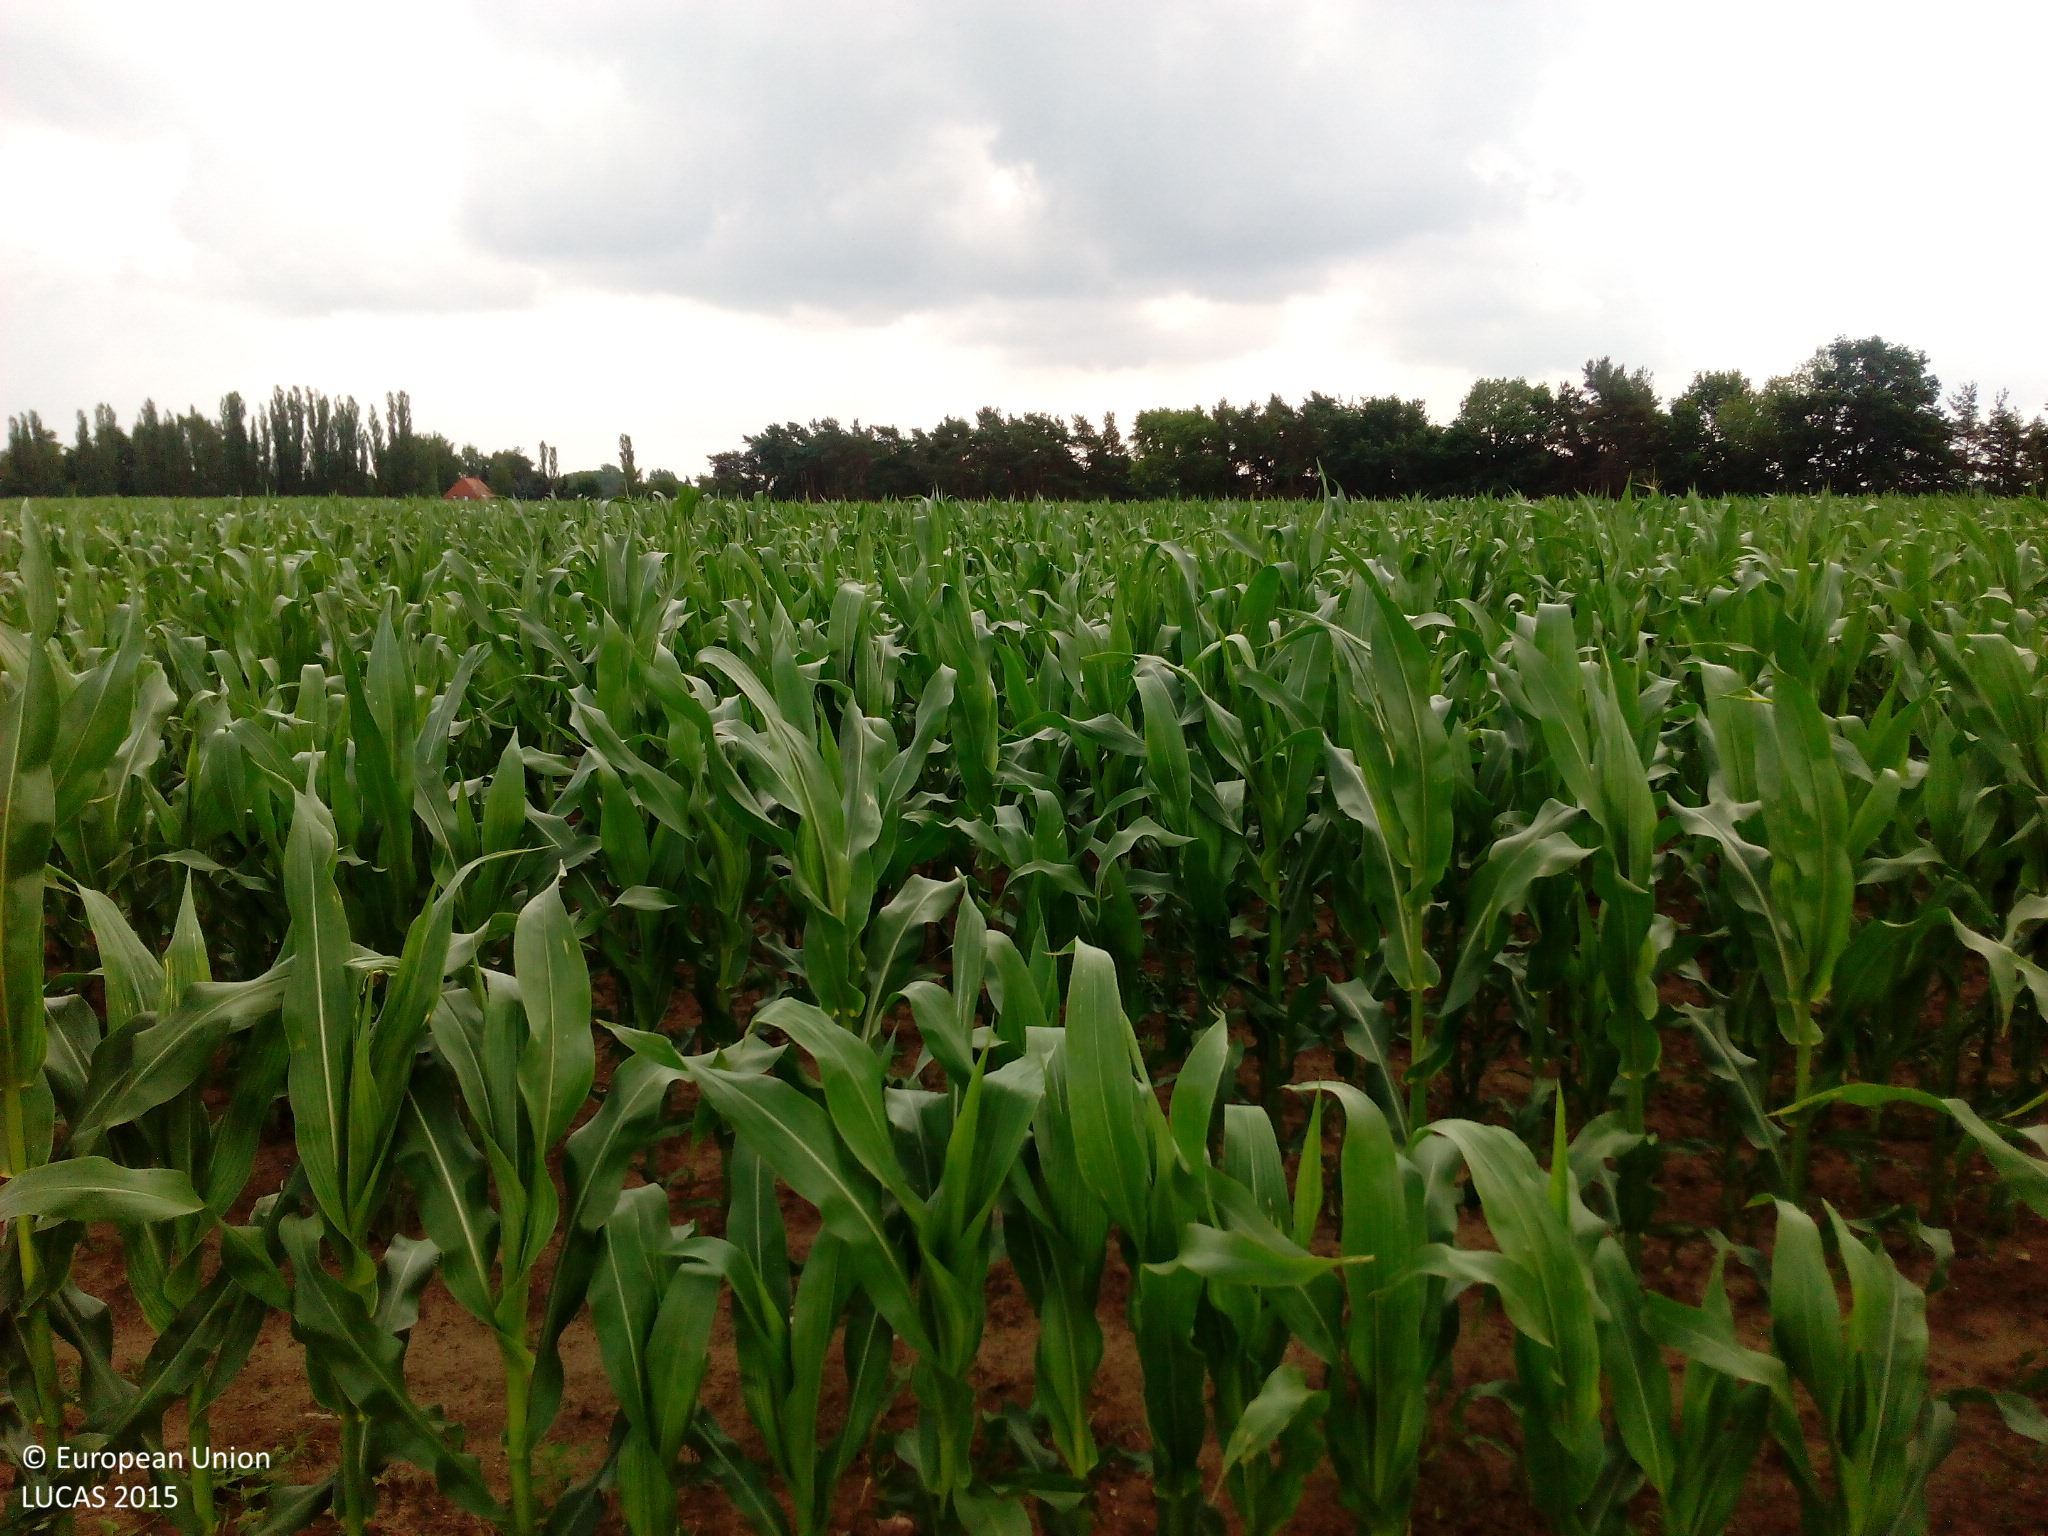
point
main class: Cropland
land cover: Maize
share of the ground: > 75 %
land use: Agriculture (excluding fallow land and kitchen gardens)
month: July
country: DE
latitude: 52.6807
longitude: 12.2034
